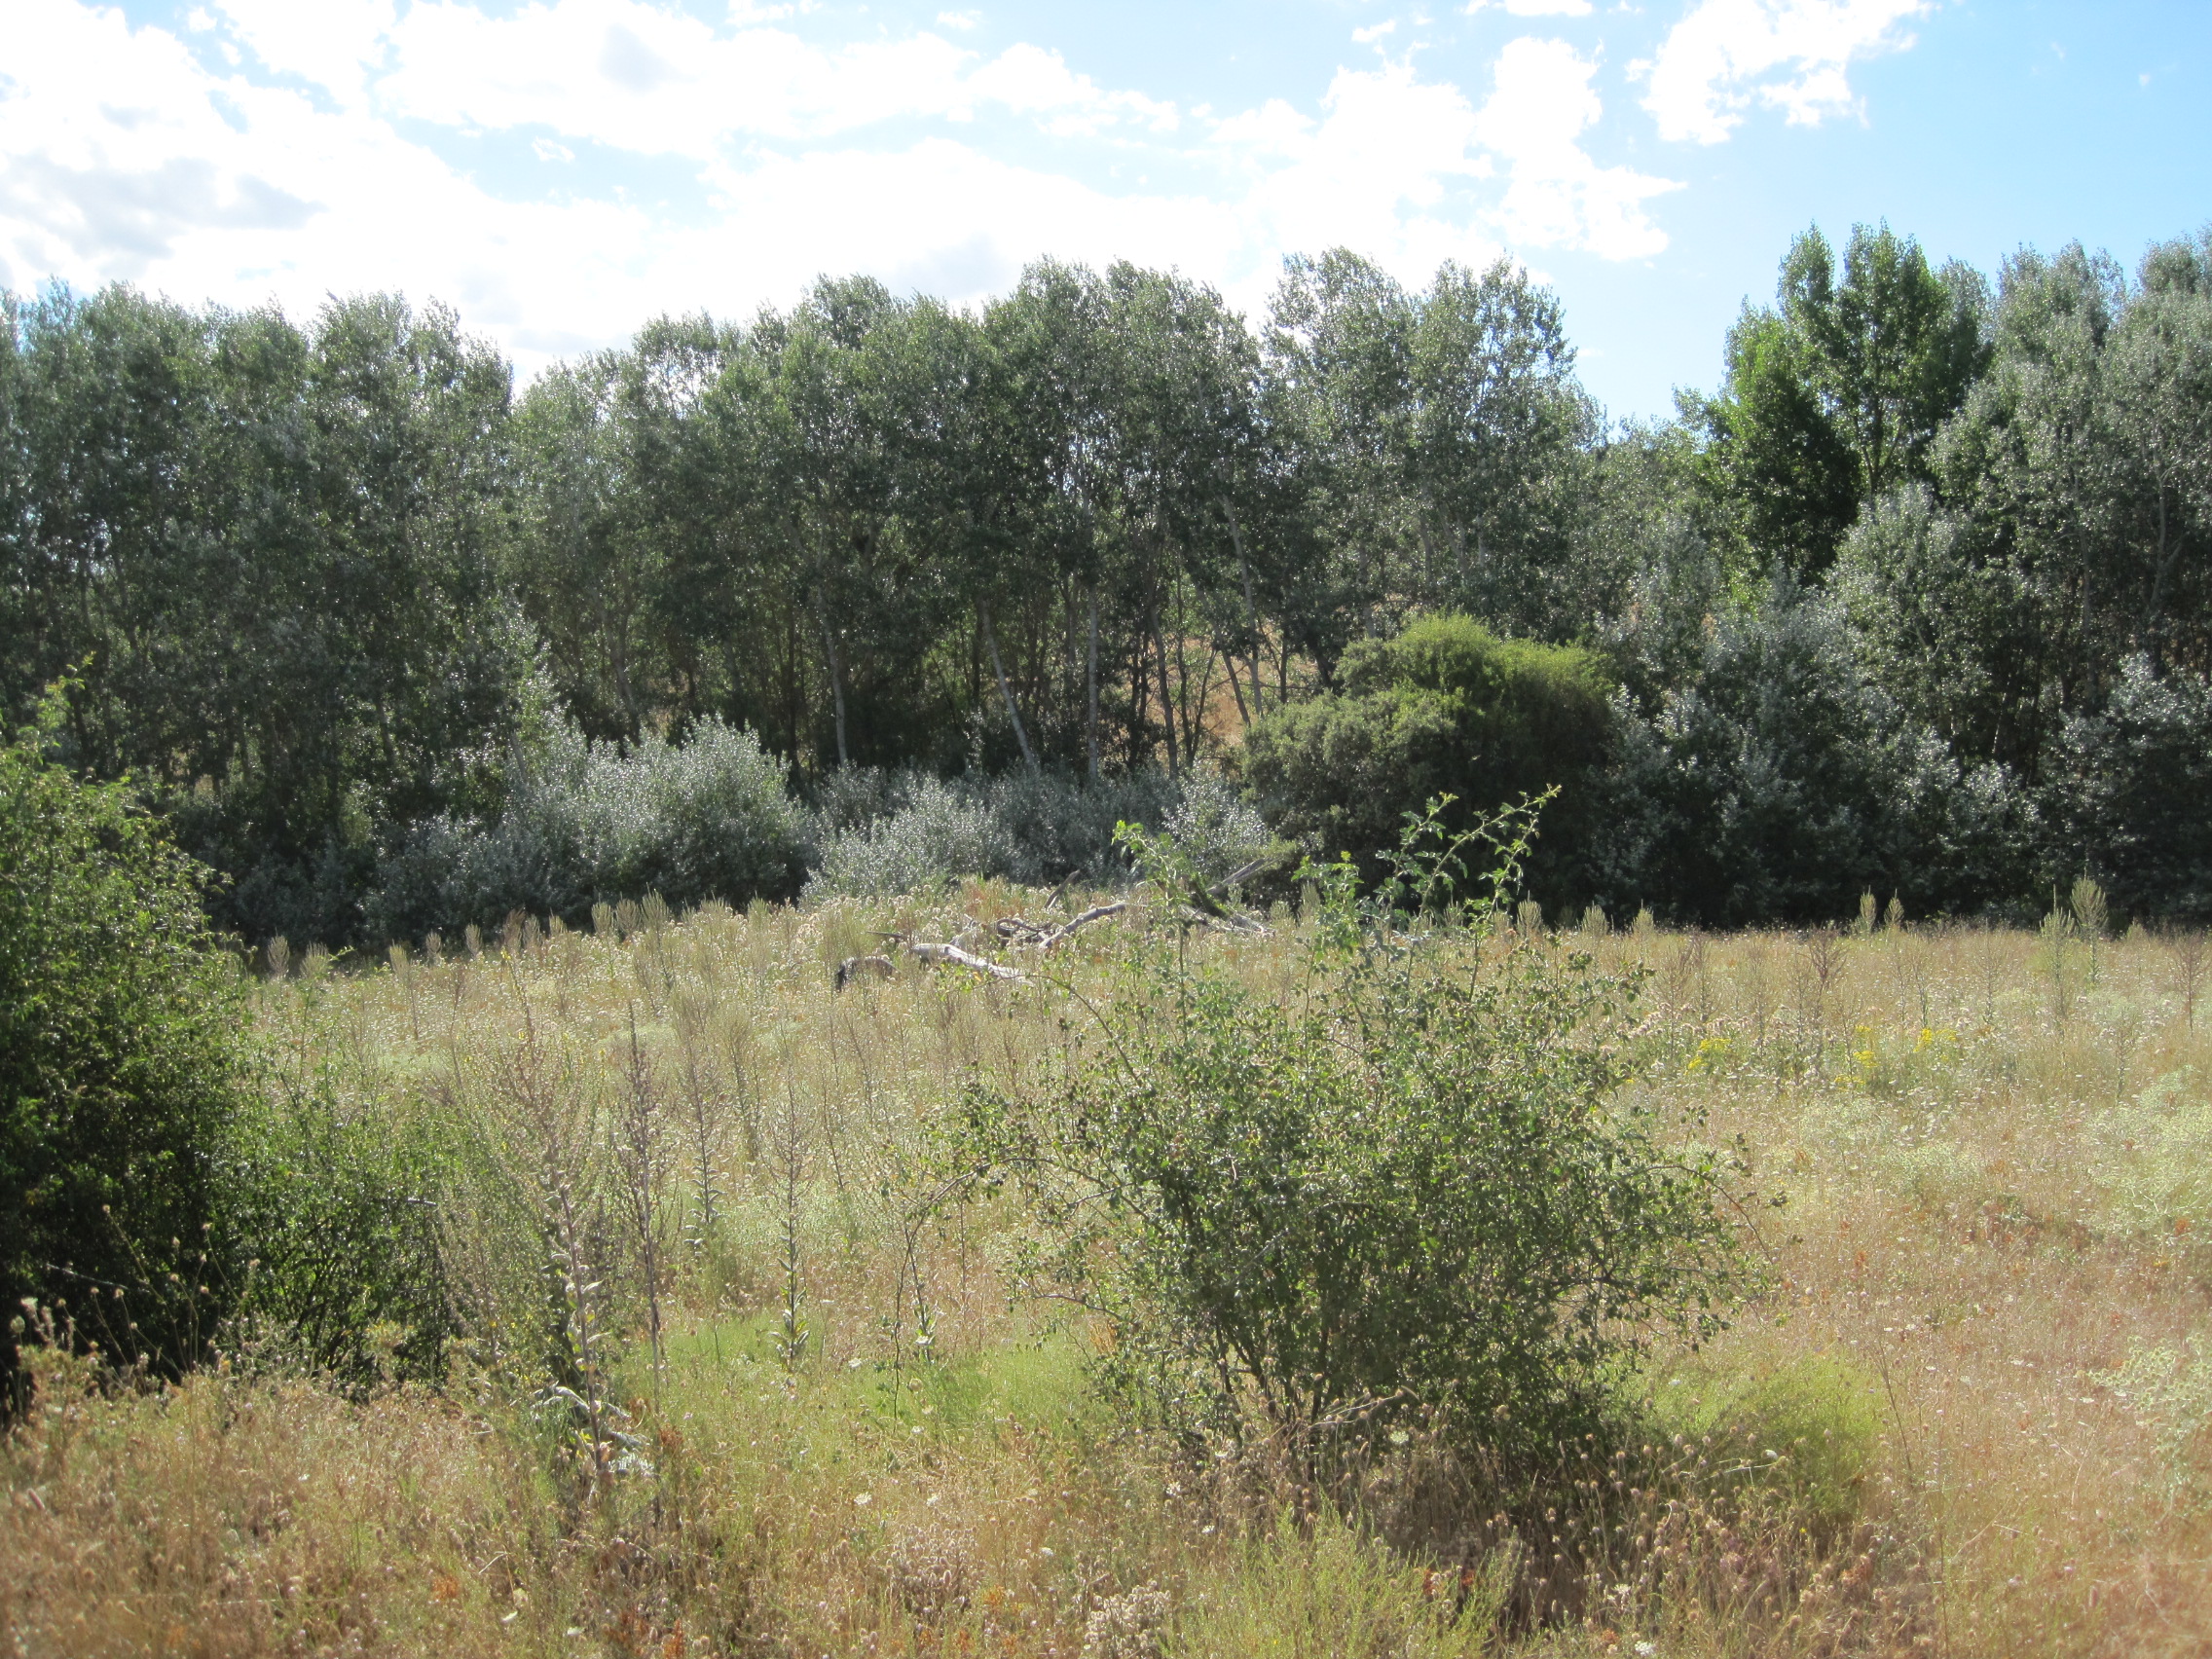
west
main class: Grassland
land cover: Grassland without tree/shrub cover
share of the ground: > 75 %
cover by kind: herbaceous plants 95 %, shrubs 5 %
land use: Semi-natural and natural areas not in use
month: July
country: ES
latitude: 42.0978
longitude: -5.4813
